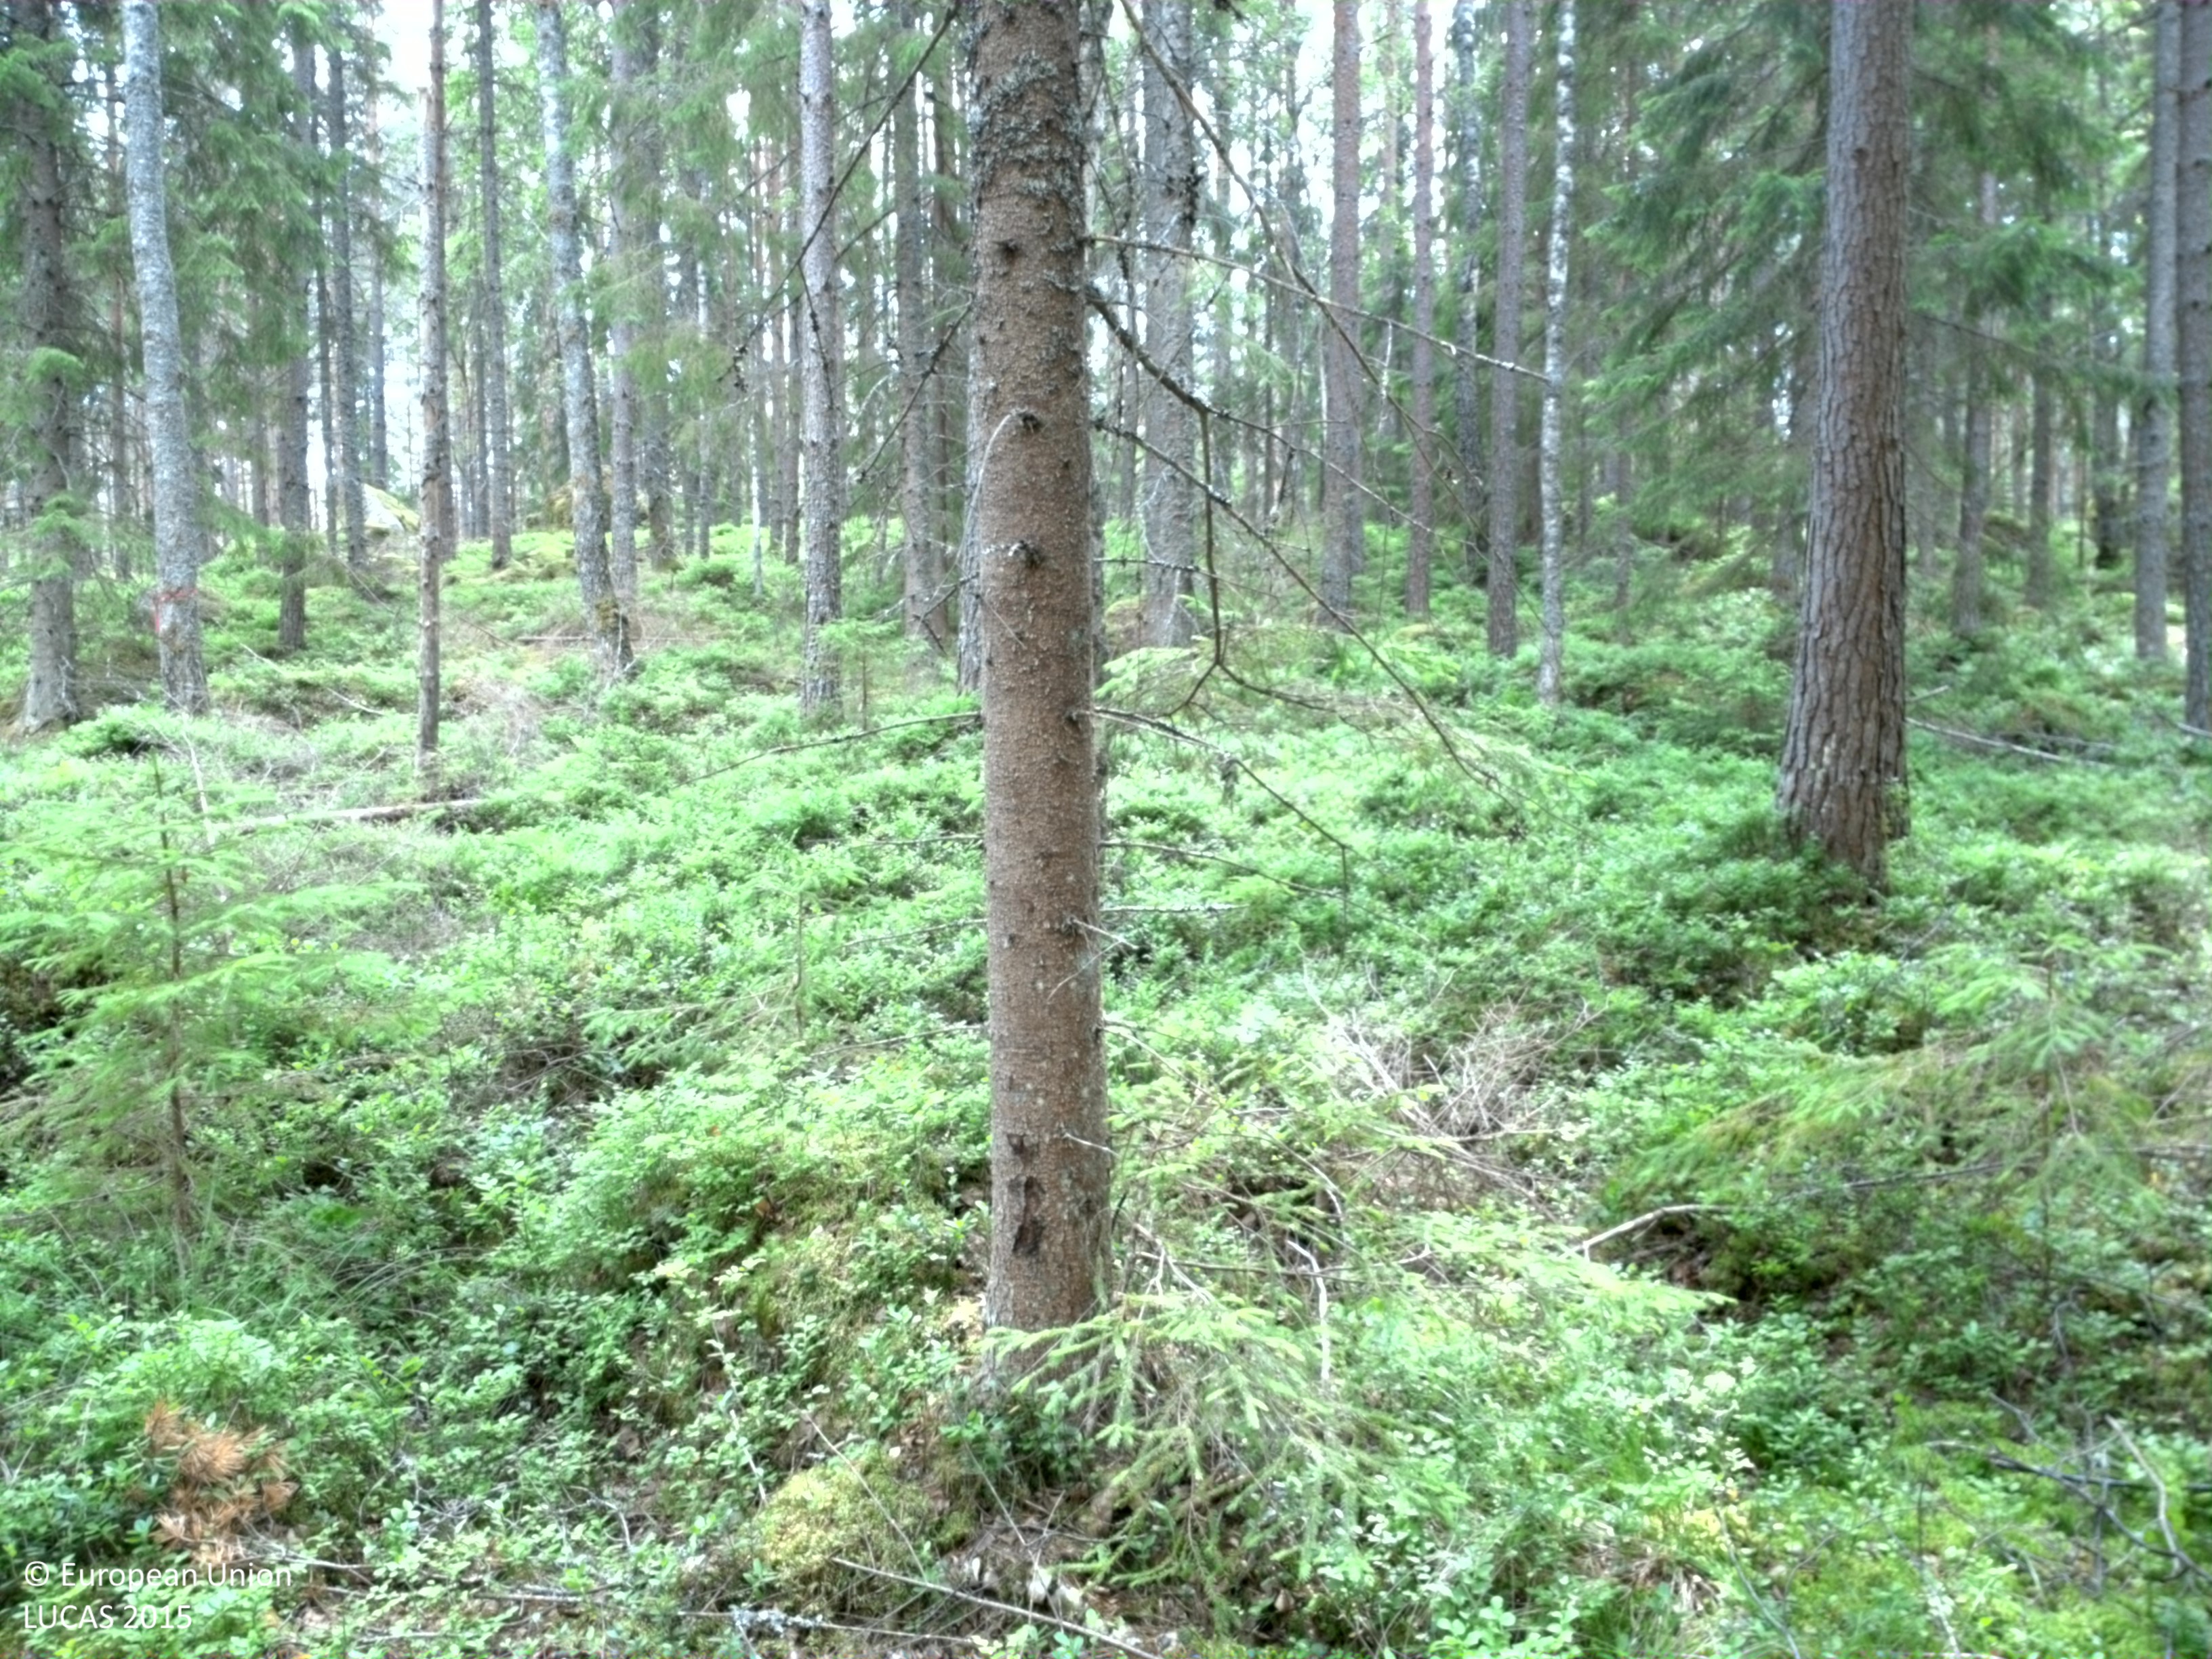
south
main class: Woodland
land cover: Spruce dominated mixed woodland
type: boreal forest
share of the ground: 25 - 50 %
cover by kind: herbaceous plants 35 %, coniferous forest trees 30 %, lichens and mosses 20 %, broadleaved forest trees 15 %
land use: Forestry
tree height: > 5 m
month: July
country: SE
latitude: 58.8465
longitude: 14.5159
